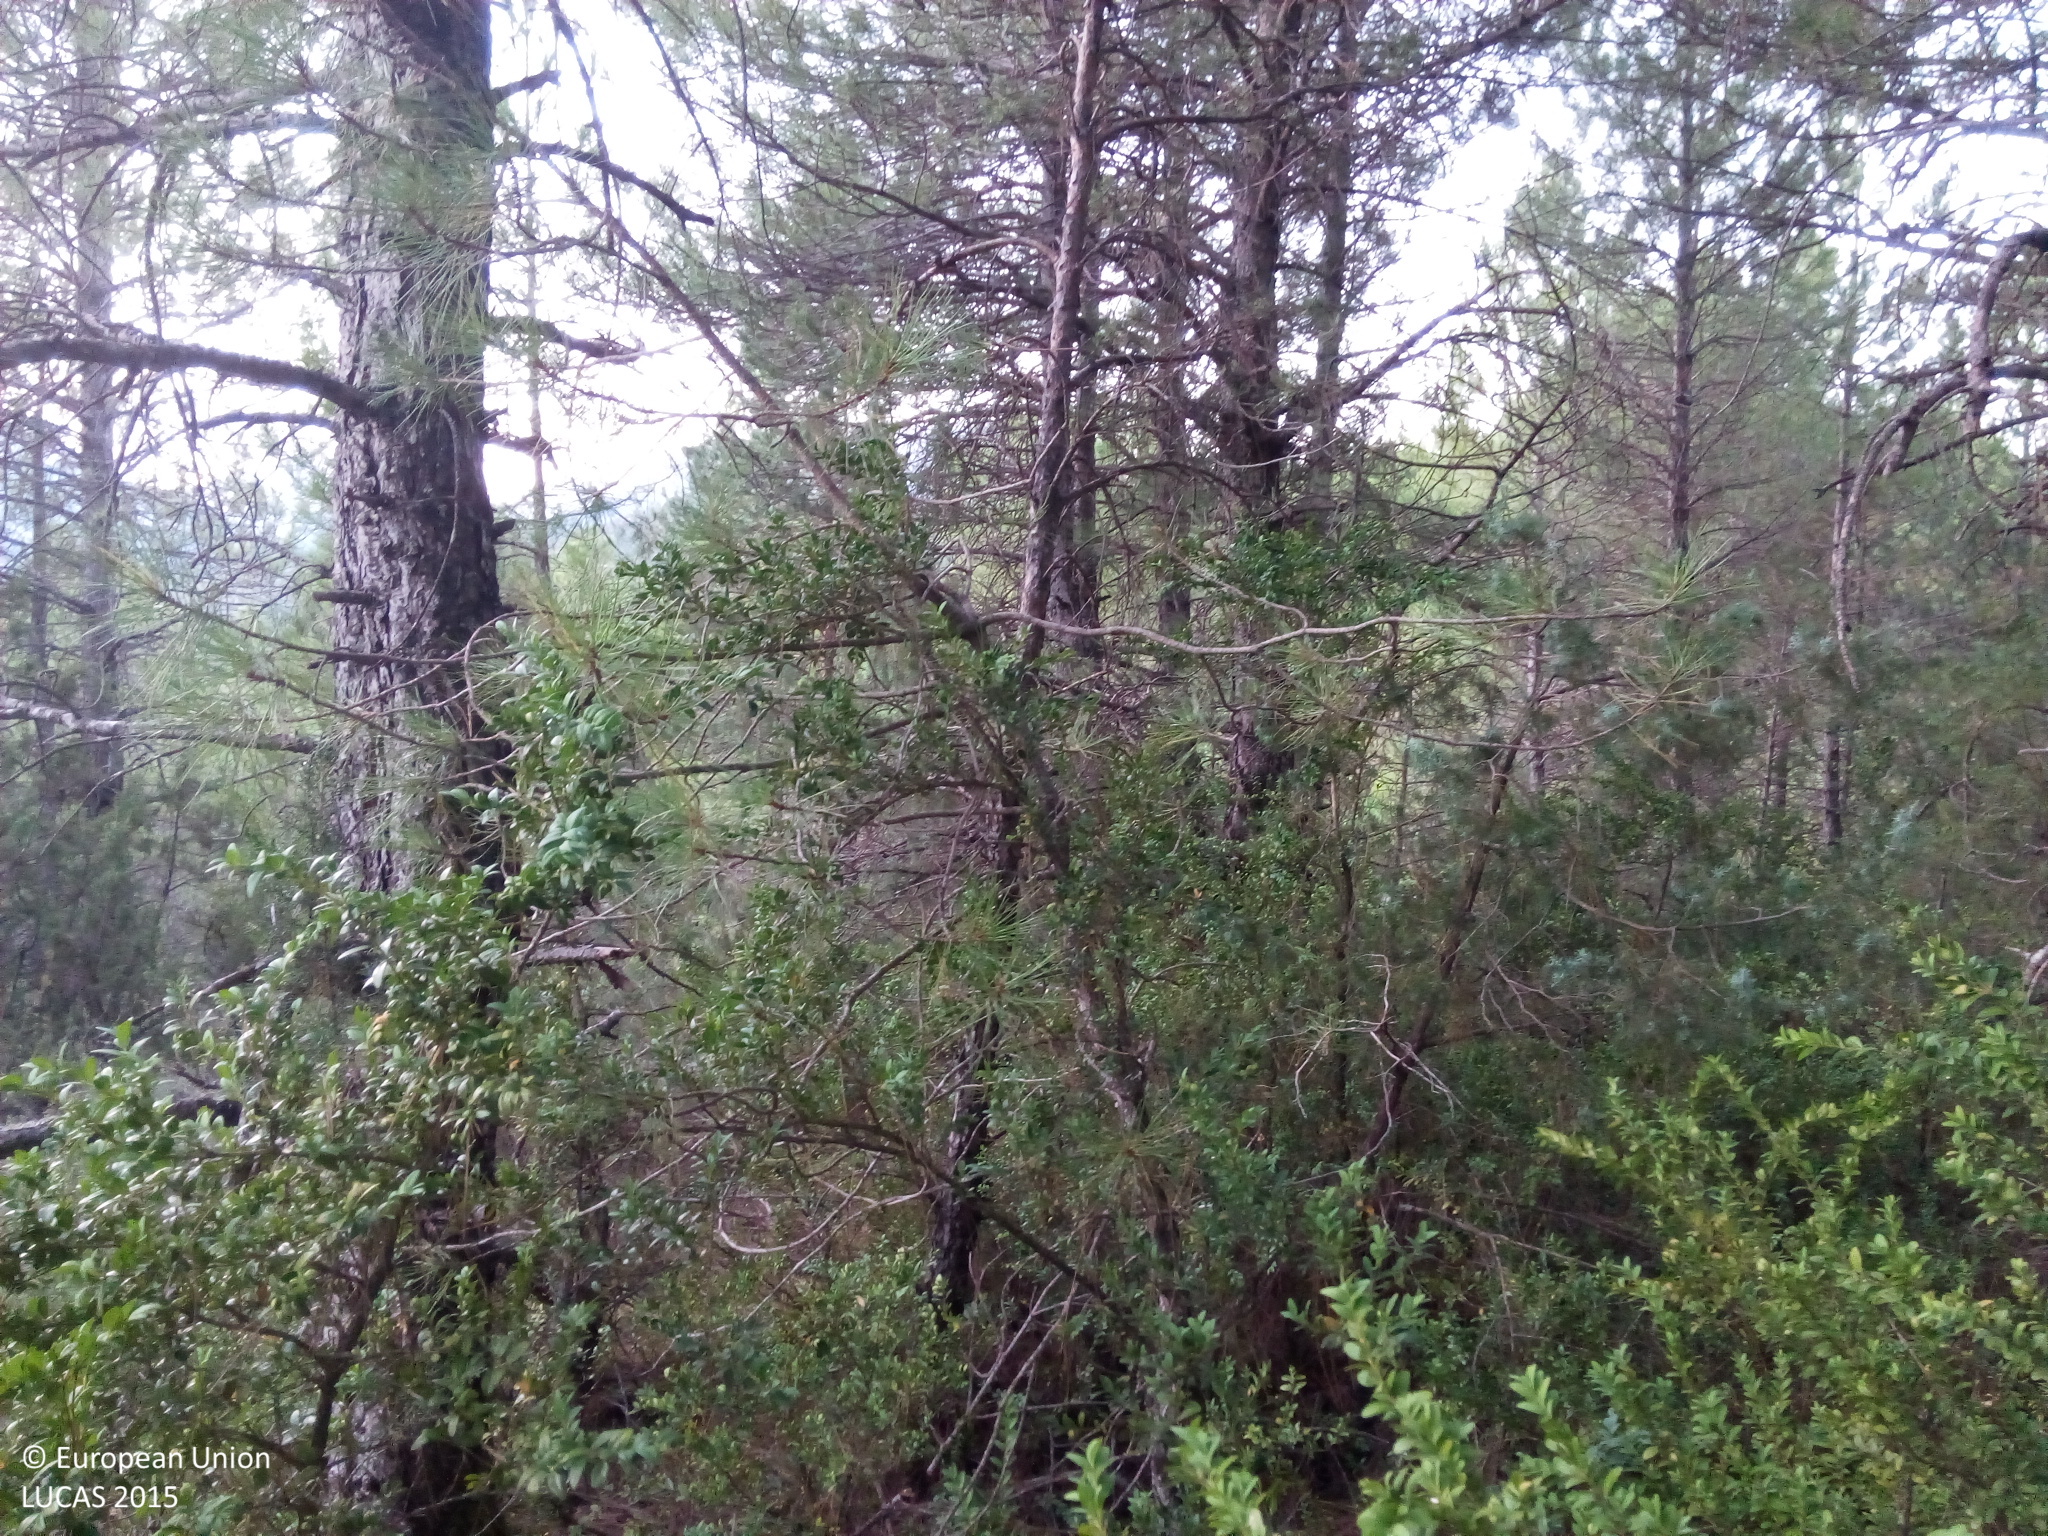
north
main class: Woodland
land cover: Pine dominated coniferous woodland
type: coniferous forest of the mediterranean region
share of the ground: > 75 %
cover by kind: coniferous forest trees 95 %, shrubs 5 %
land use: Forestry
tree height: > 5 m
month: August
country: ES
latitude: 42.5164
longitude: 0.1311
